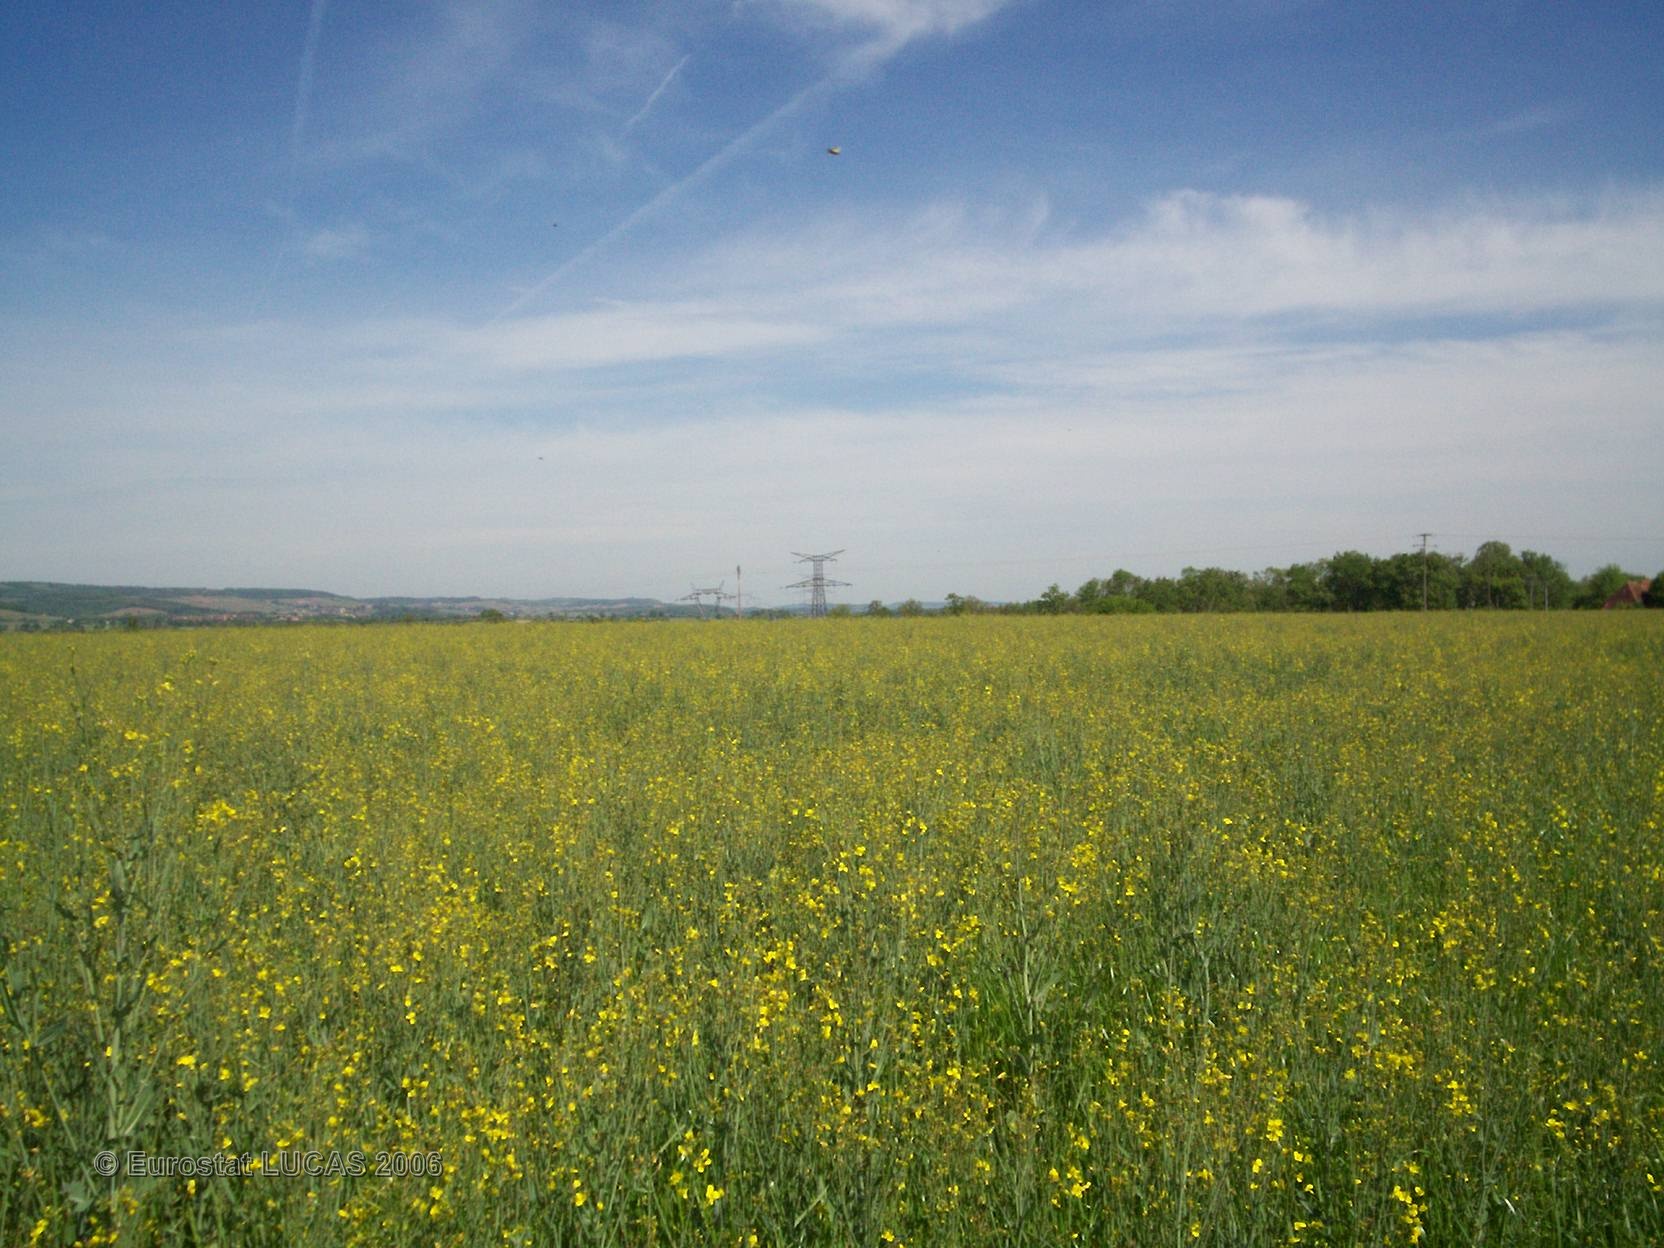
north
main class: Grassland
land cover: Grassland without tree/shrub cover
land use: Agriculture (excluding fallow land and kitchen gardens)
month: May
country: FR
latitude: 46.5996
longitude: 4.7146
